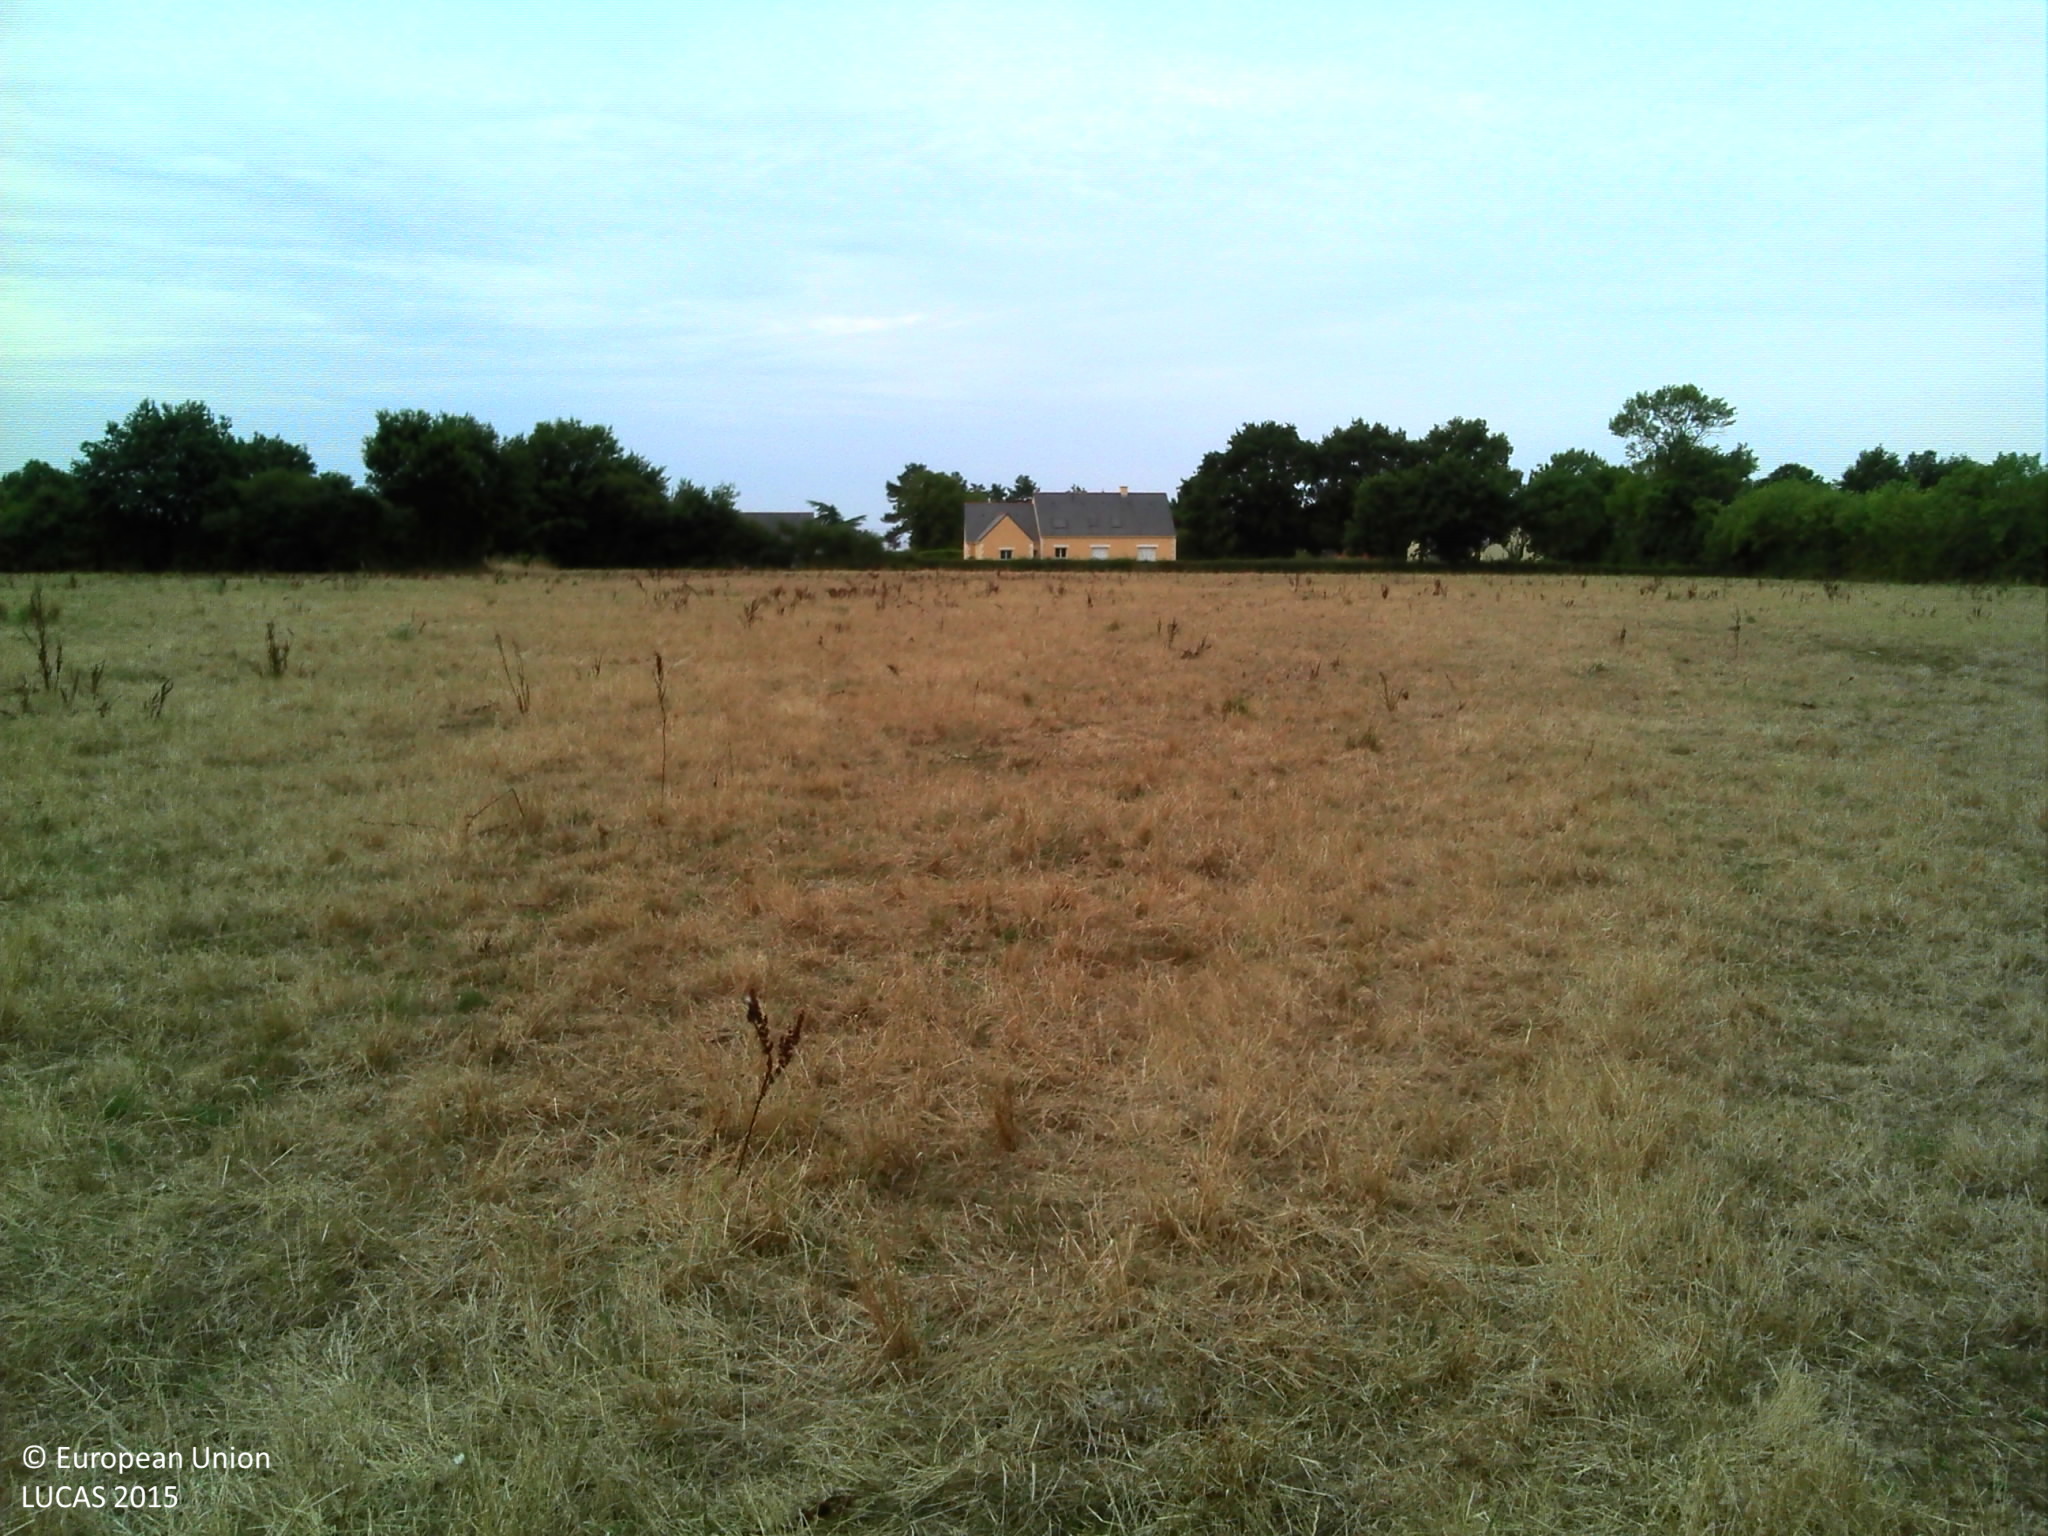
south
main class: Grassland
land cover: Grassland without tree/shrub cover
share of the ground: > 75 %
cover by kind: herbaceous plants 100 %
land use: Agriculture (excluding fallow land and kitchen gardens)
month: August
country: FR
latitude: 47.4813
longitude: -1.6027
